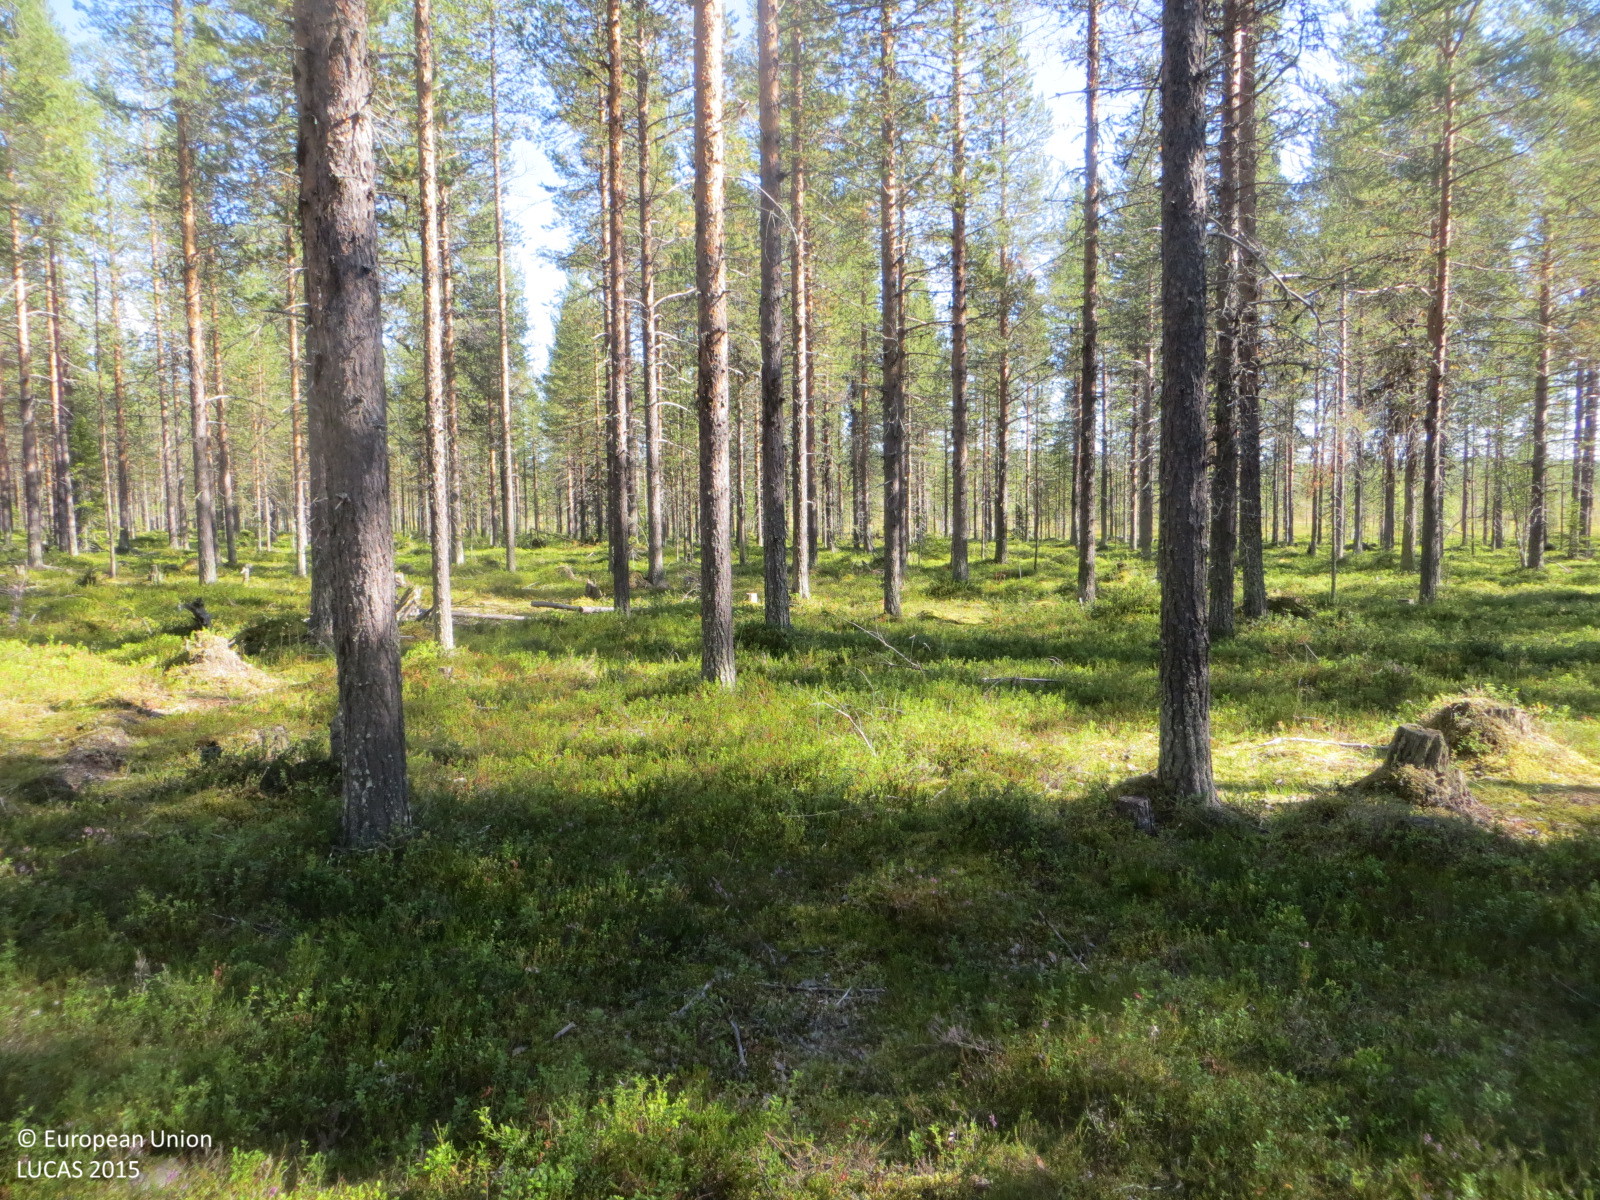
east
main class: Woodland
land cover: Pine dominated coniferous woodland
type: boreal forest
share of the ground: 50 - 75 %
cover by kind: coniferous forest trees 50 %, shrubs 50 %
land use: Forestry
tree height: > 5 m
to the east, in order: Pine dominated coniferous woodland; Pine dominated mixed woodland
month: August
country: FI
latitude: 67.5234
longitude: 23.9211
